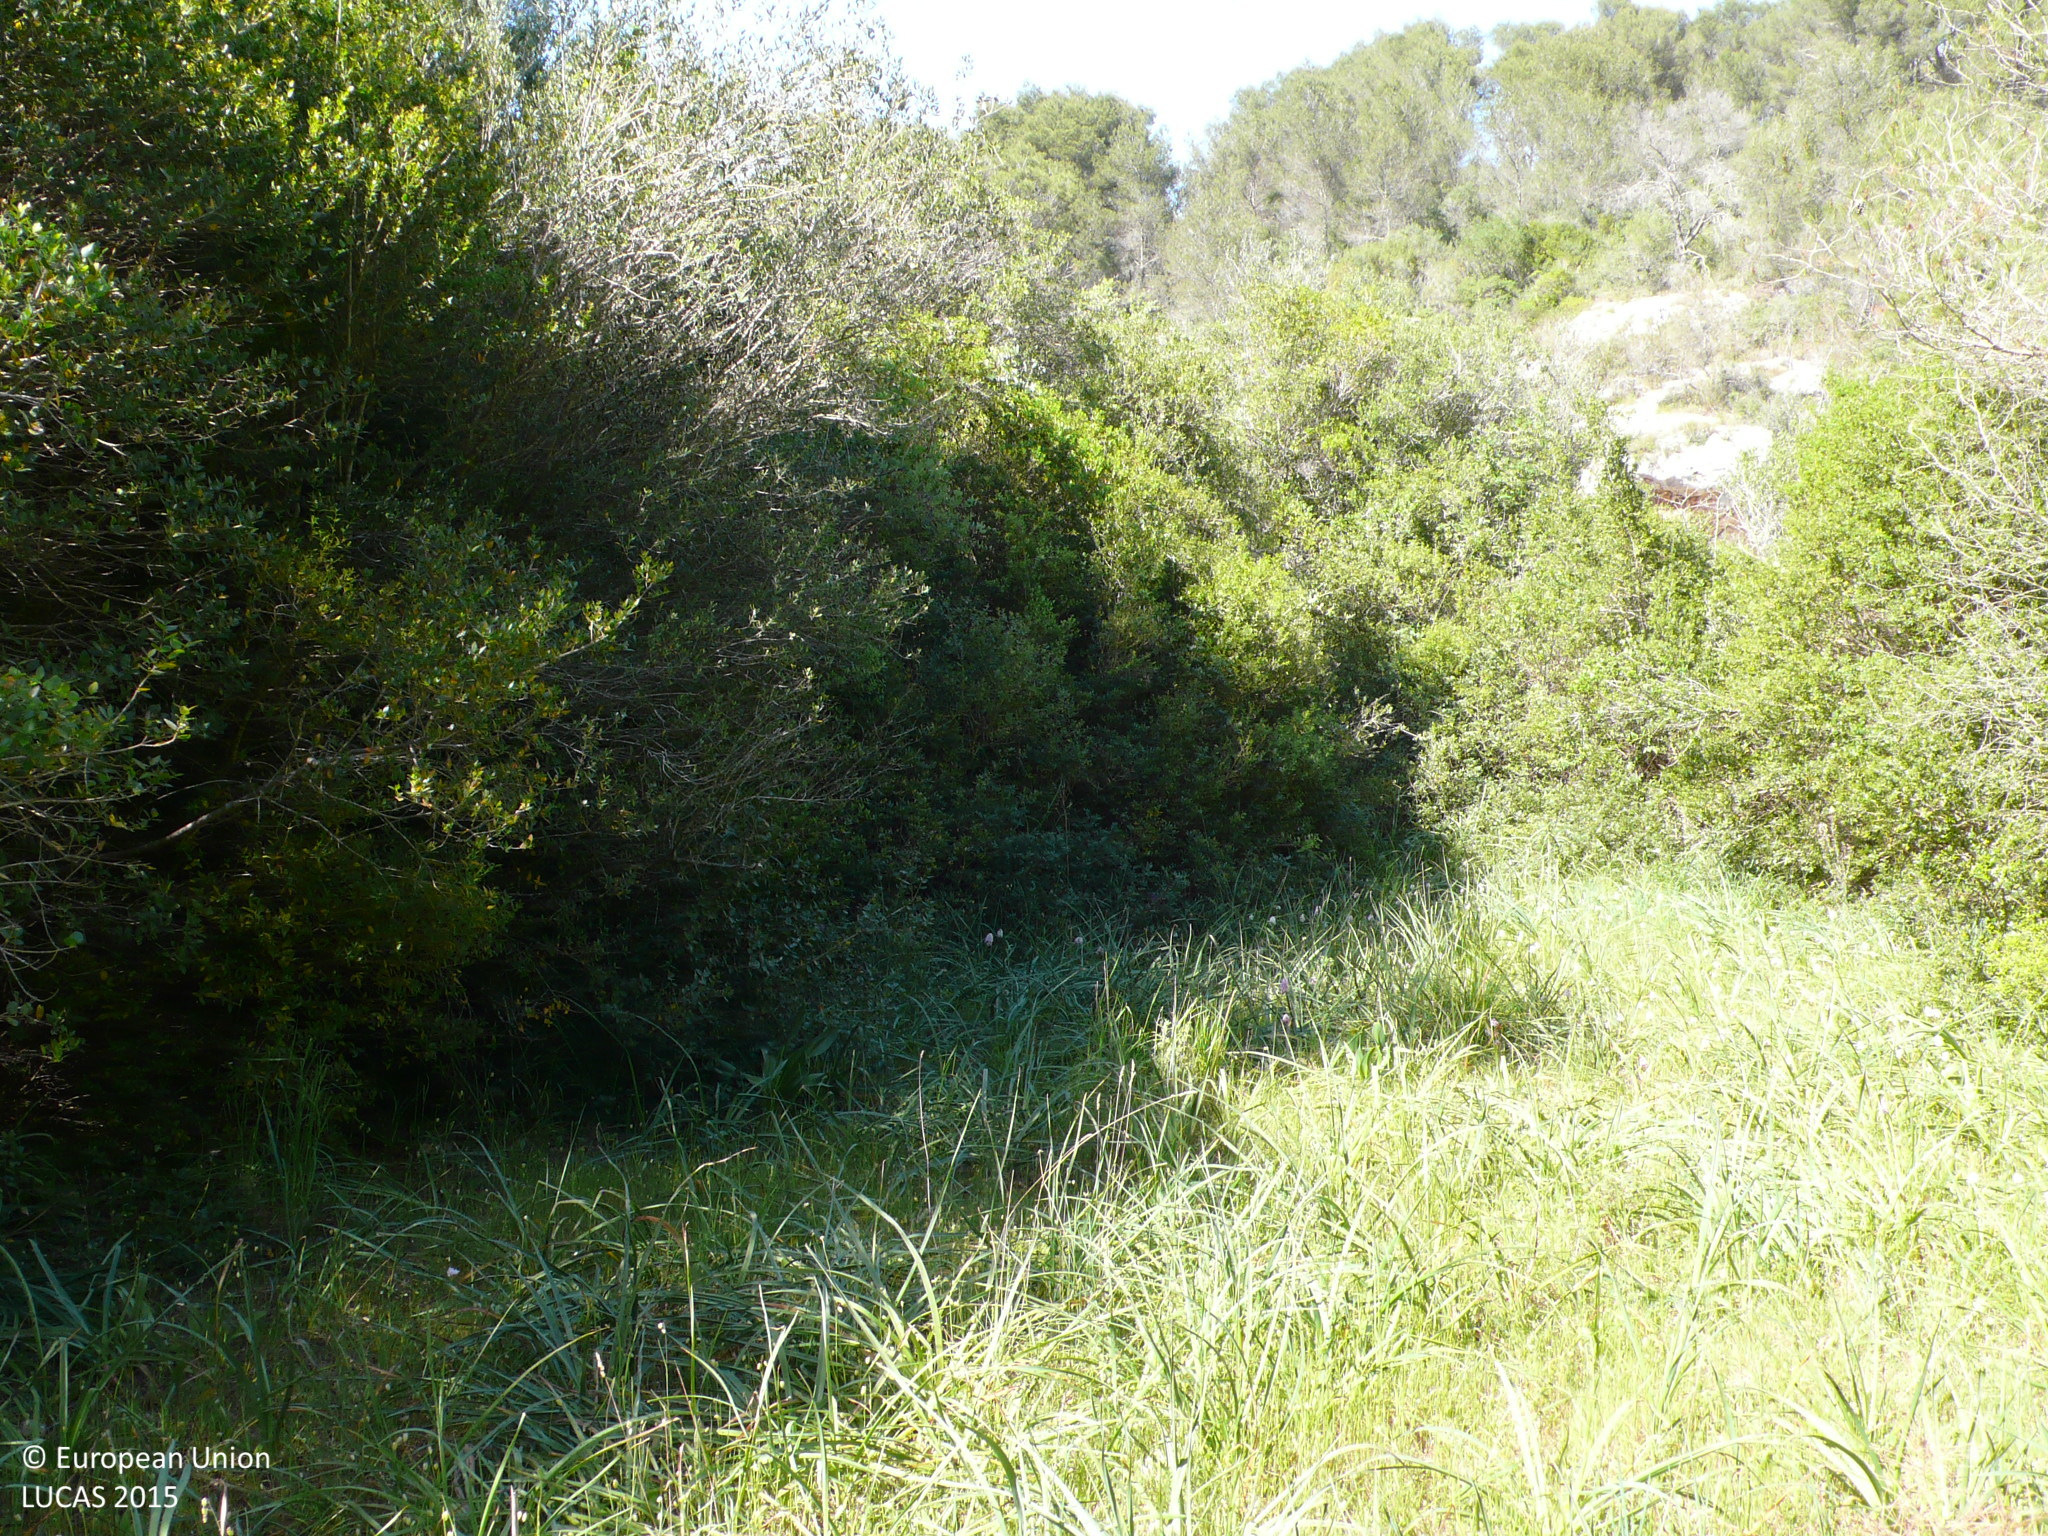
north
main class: Woodland
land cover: Other mixed woodland
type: coniferous forest of the mediterranean region
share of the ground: > 75 %
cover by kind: coniferous forest trees 50 %, broadleaved forest trees 45 %, shrubs 5 %
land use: Semi-natural and natural areas not in use
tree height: > 5 m
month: May
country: ES
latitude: 39.9260
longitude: 4.0940
